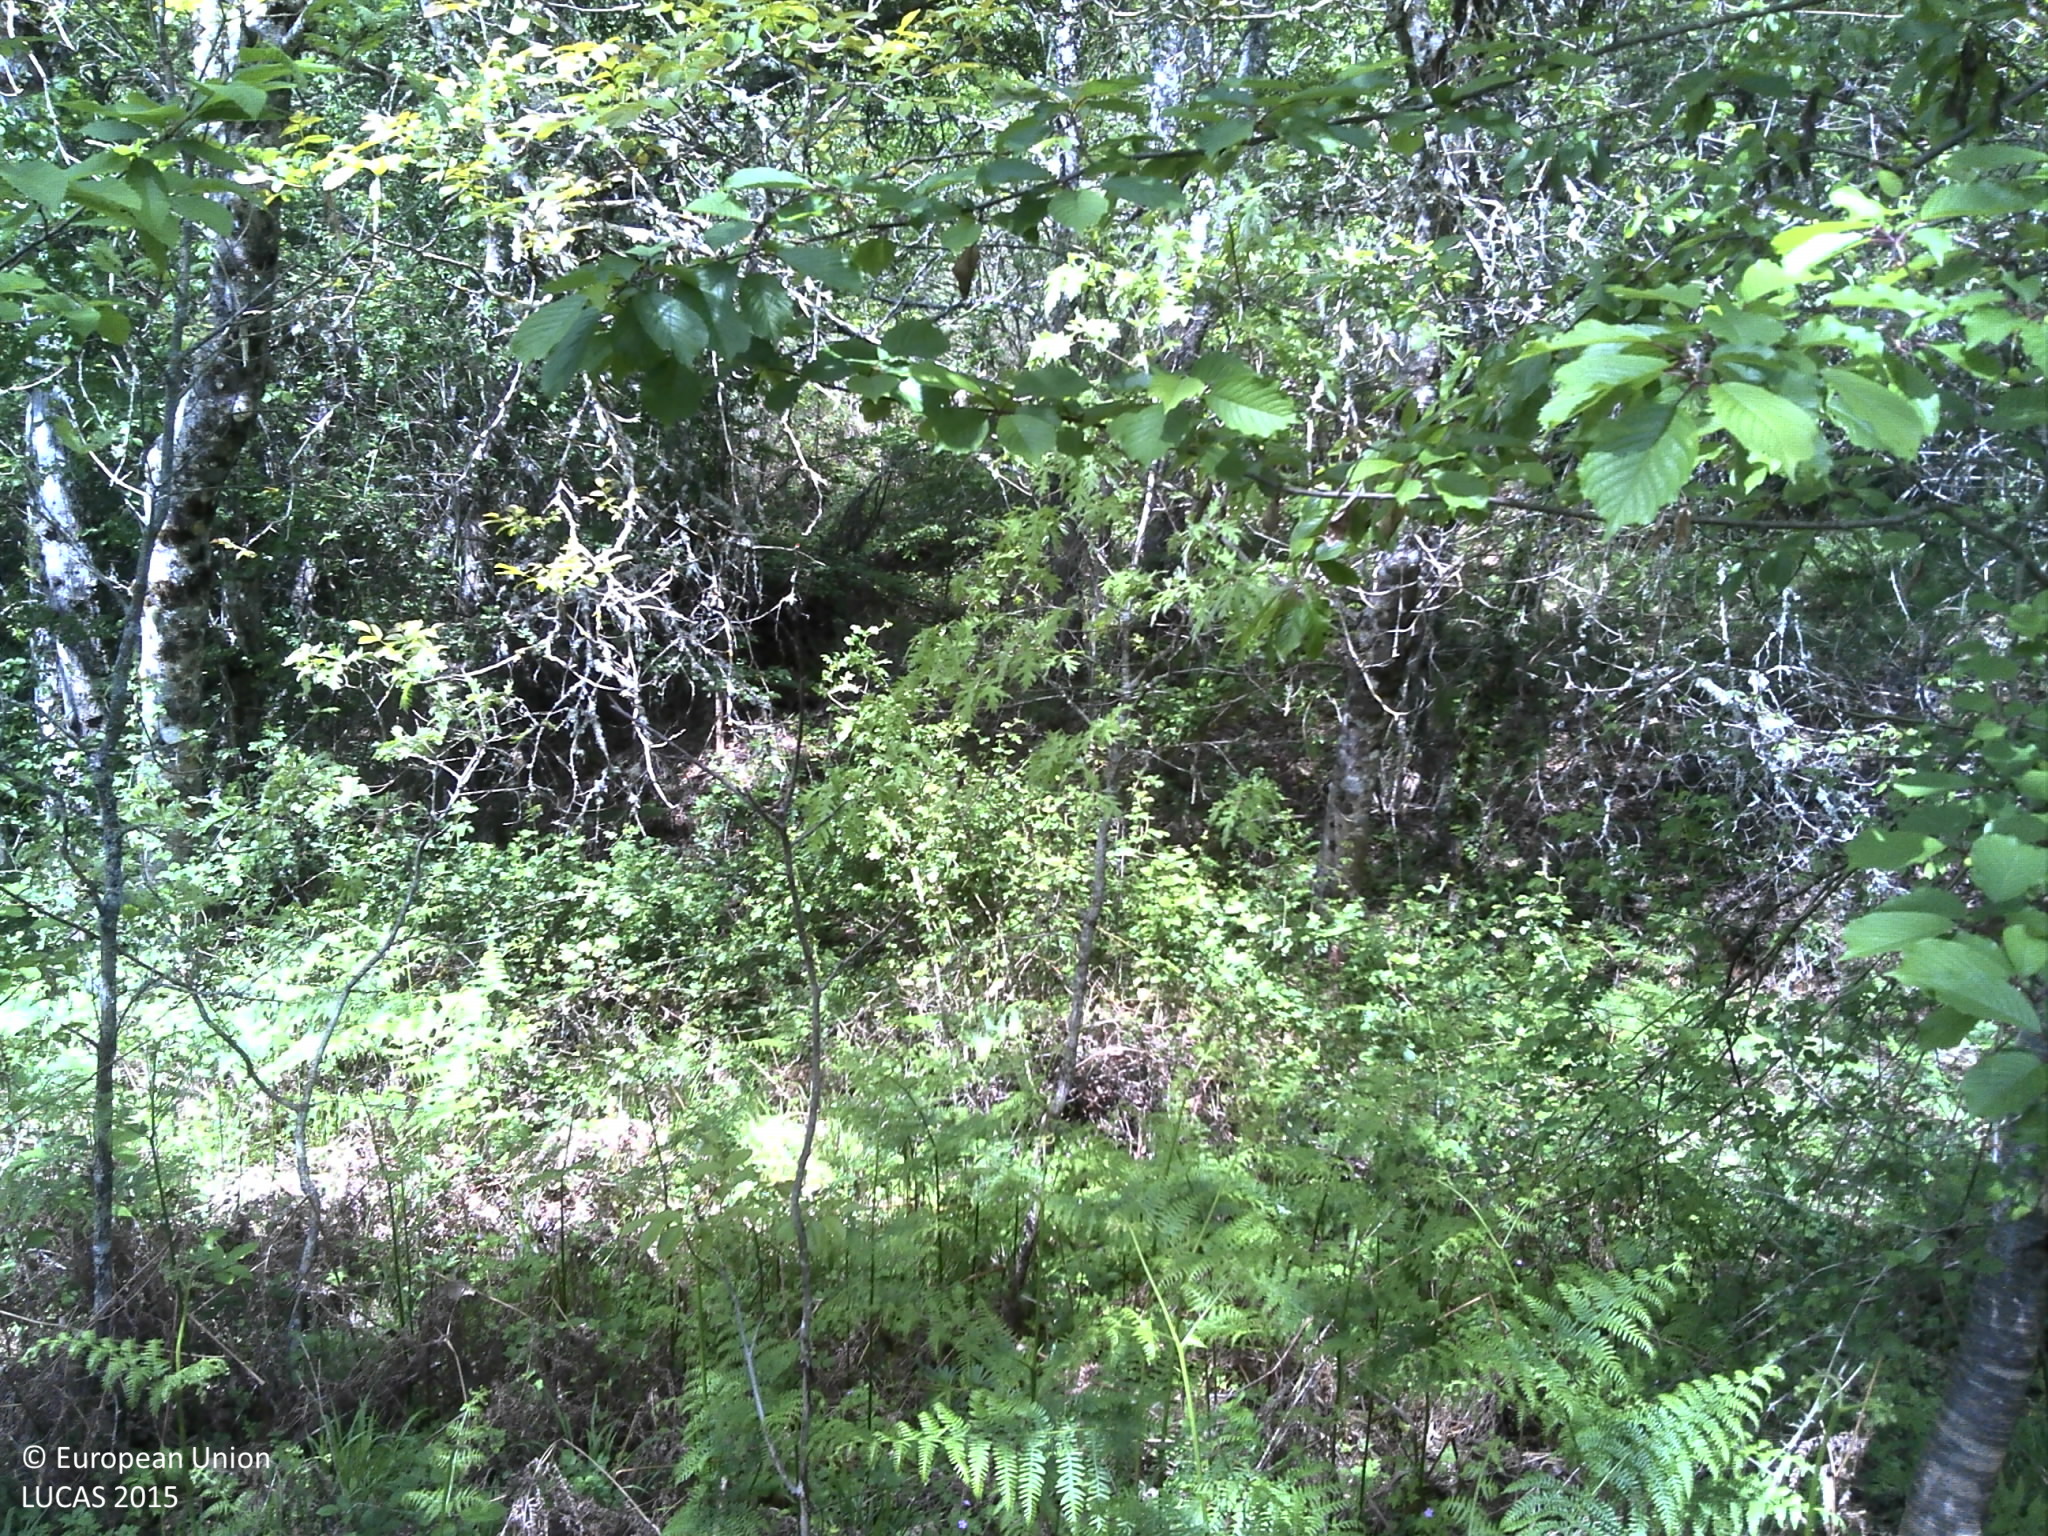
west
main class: Woodland
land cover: Broadleaved woodland
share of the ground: 25 - 50 %
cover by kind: broadleaved forest trees 50 %, unconsolidated bare surface 30 %, shrubs 10 %, herbaceous plants 10 %
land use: Forestry
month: May
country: PT
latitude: 41.8811
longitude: -7.0276
